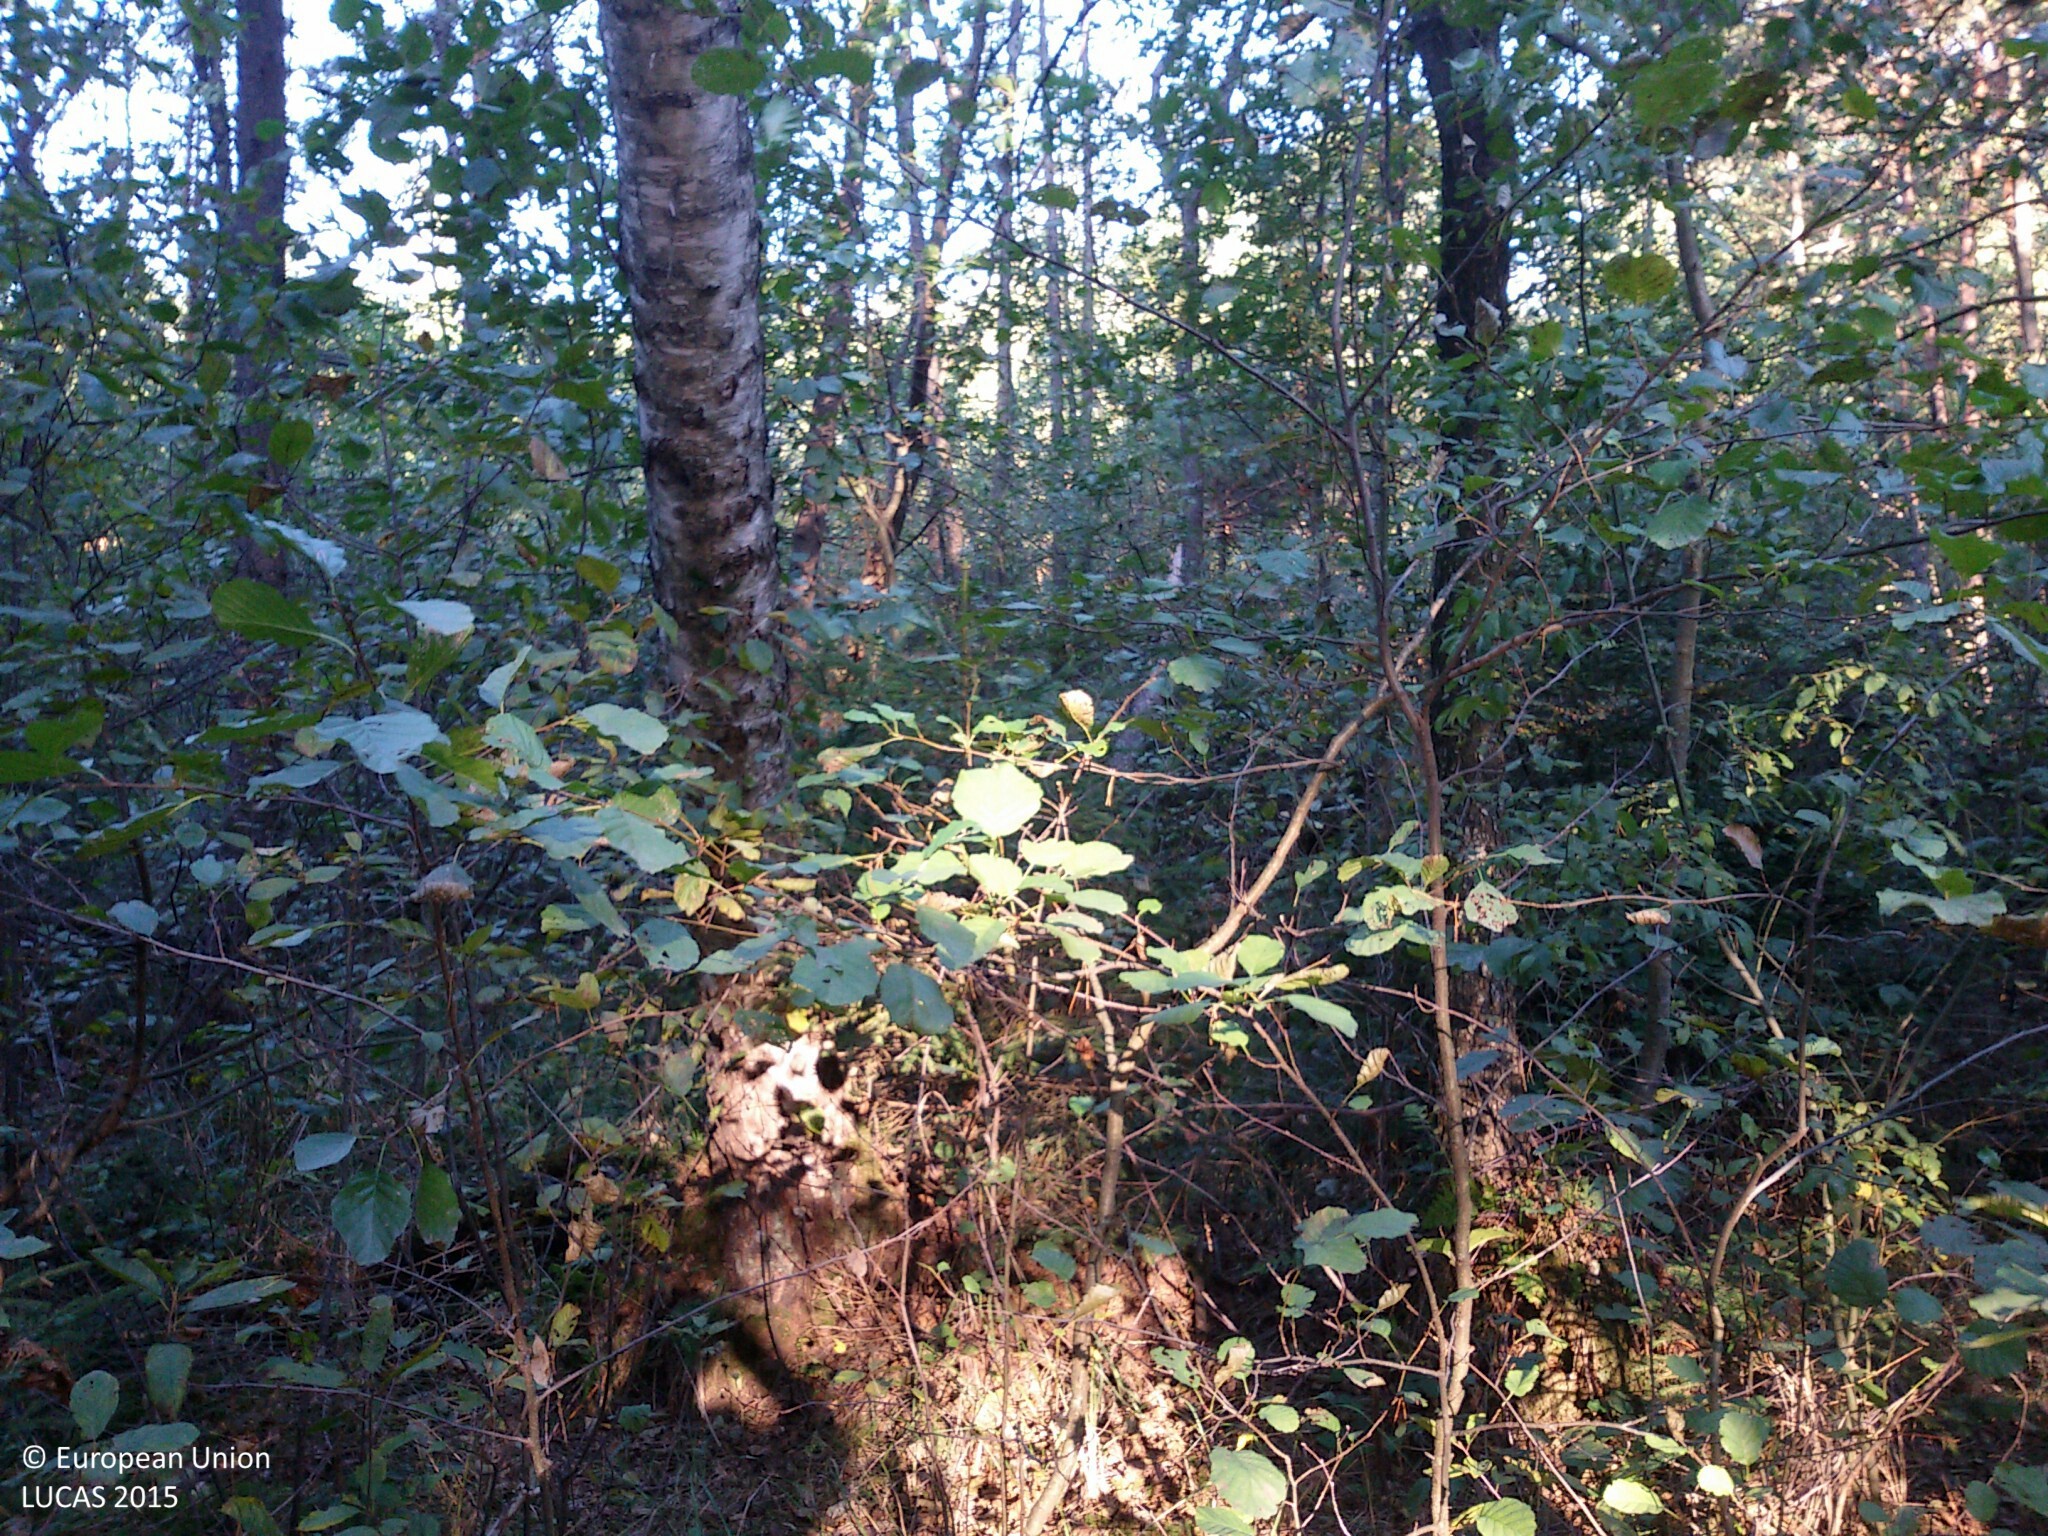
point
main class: Woodland
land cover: Other mixed woodland
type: hemiboreal forest and nemoral coniferous forest and mixed broadleaved-coniferous forest
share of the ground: > 75 %
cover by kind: broadleaved forest trees 75 %, coniferous forest trees 25 %
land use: Forestry
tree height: > 5 m
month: October
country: PL
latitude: 50.4428
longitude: 23.2735
